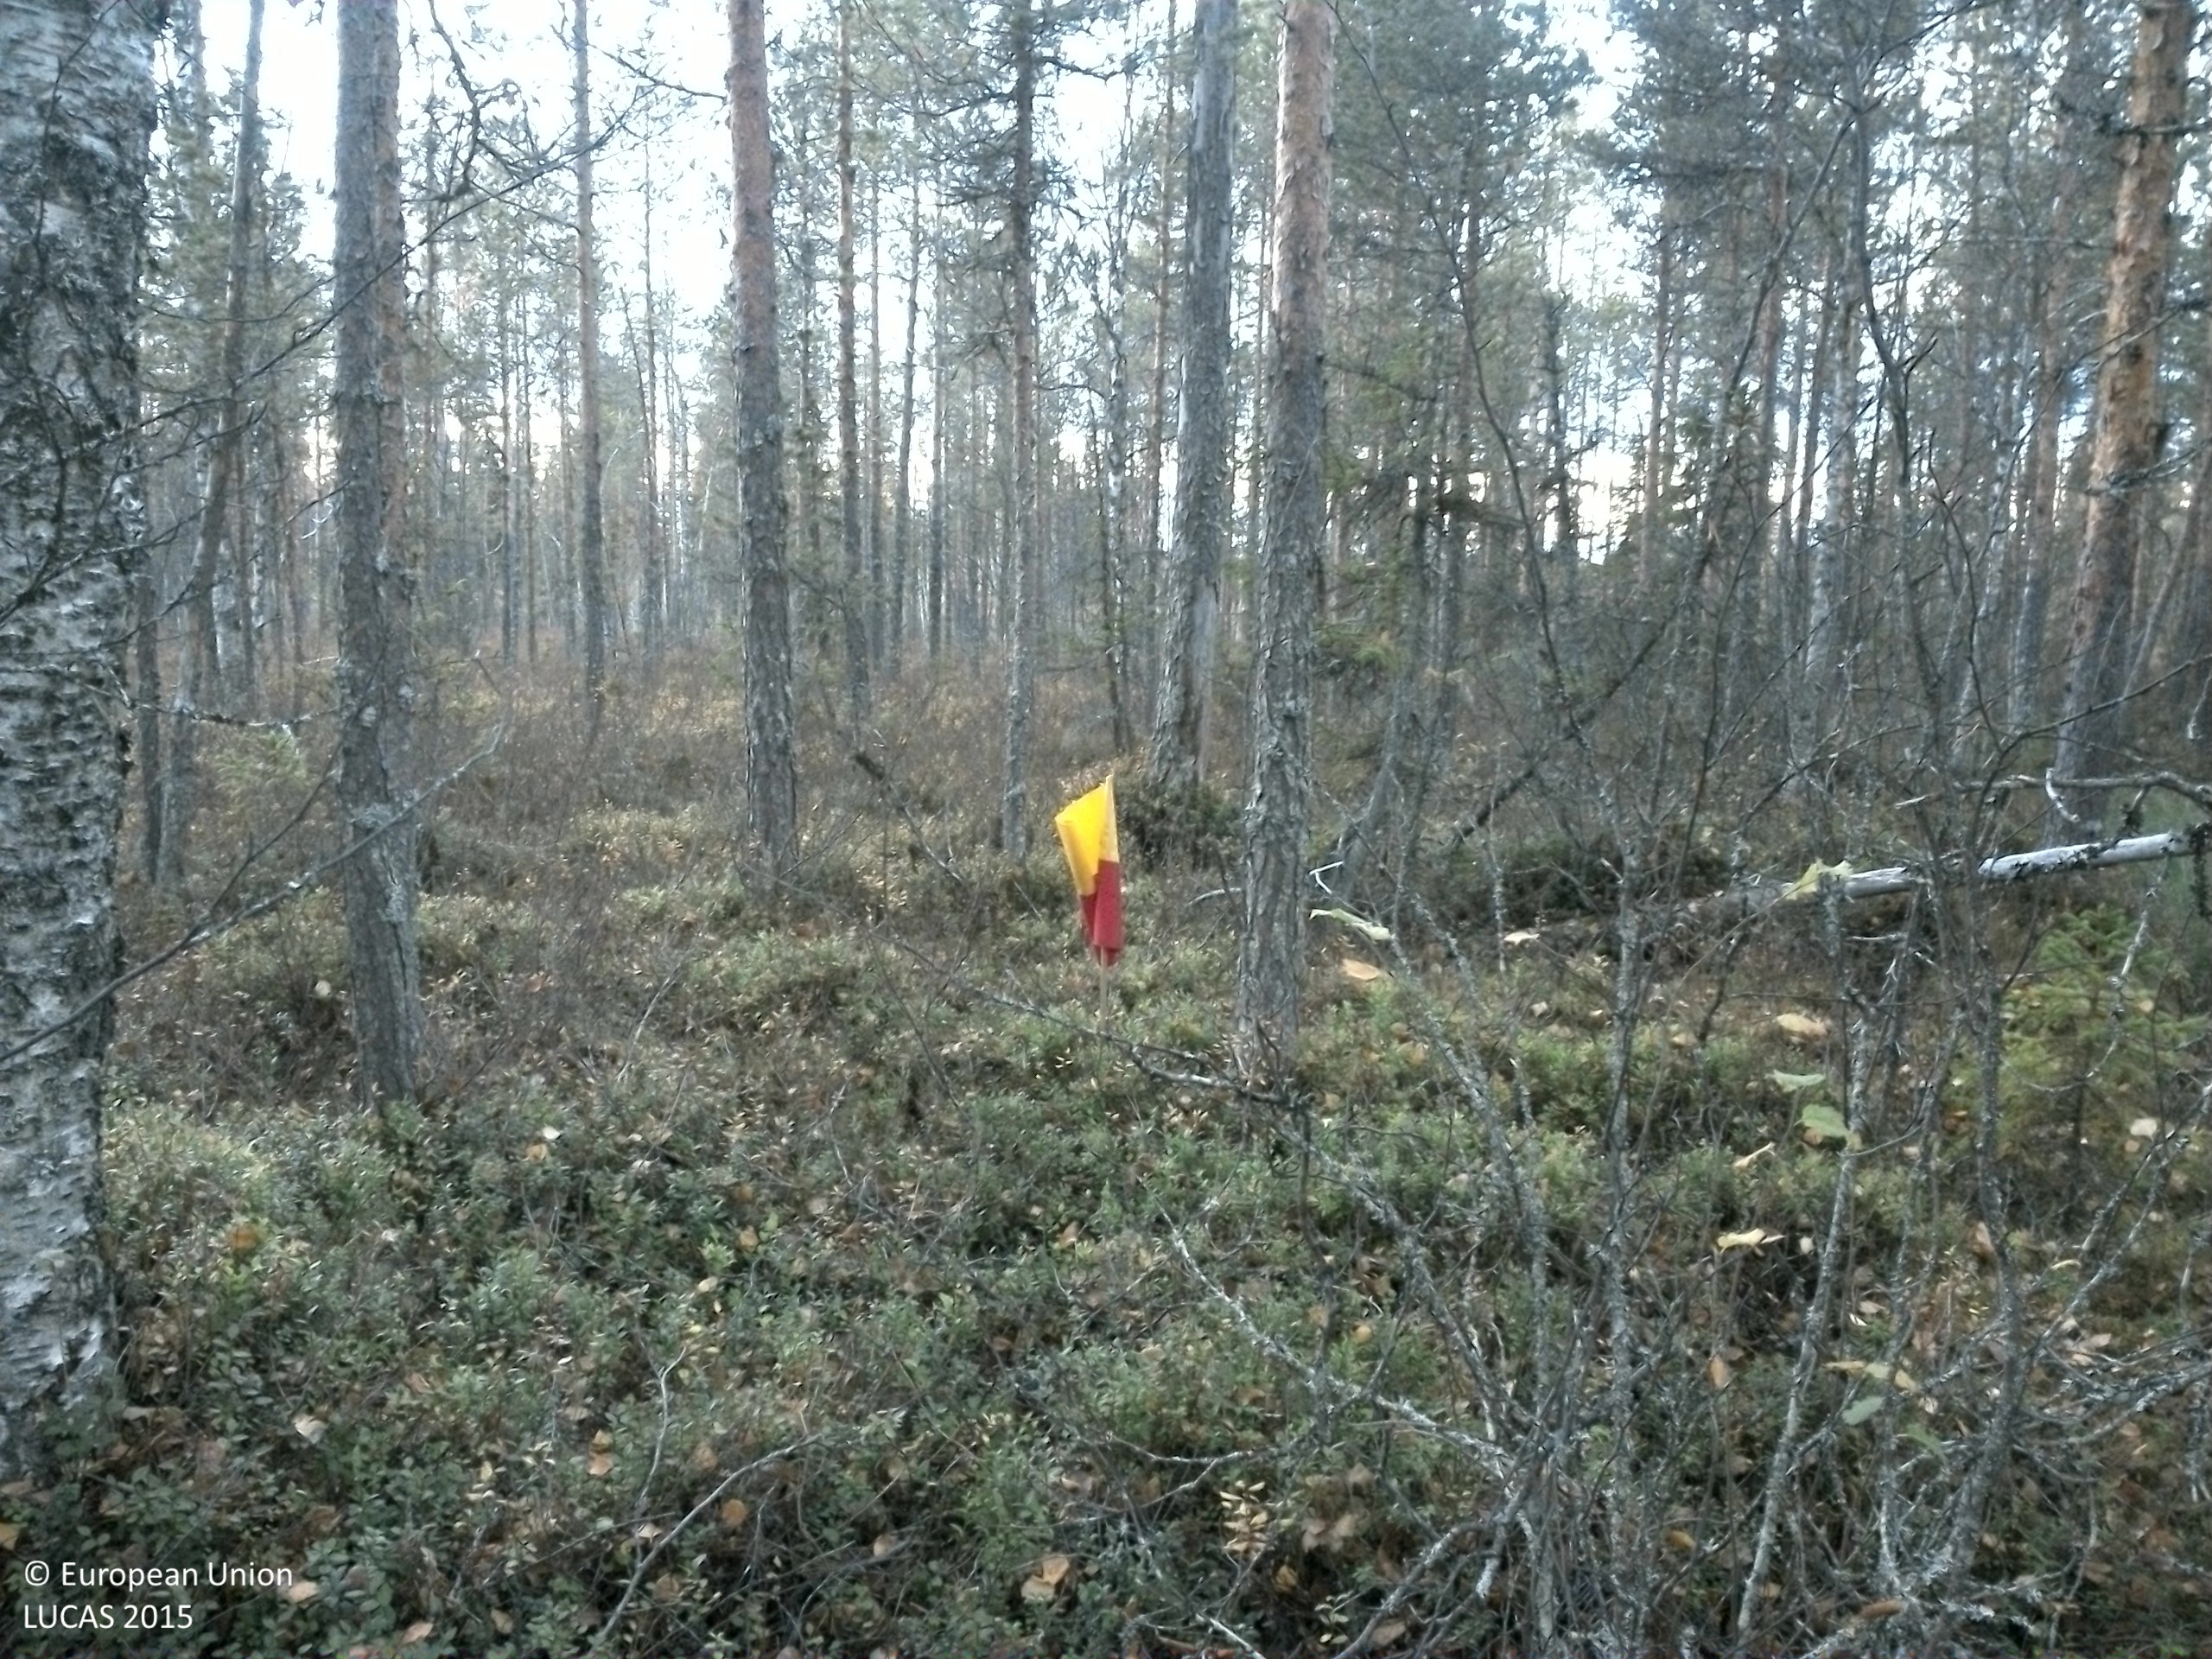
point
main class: Woodland
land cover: Pine dominated coniferous woodland
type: boreal forest
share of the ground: 25 - 50 %
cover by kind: shrubs 45 %, coniferous forest trees 35 %, broadleaved forest trees 10 %, lichens and mosses 10 %
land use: Forestry
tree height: > 5 m
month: September
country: SE
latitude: 64.2531
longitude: 16.3451
